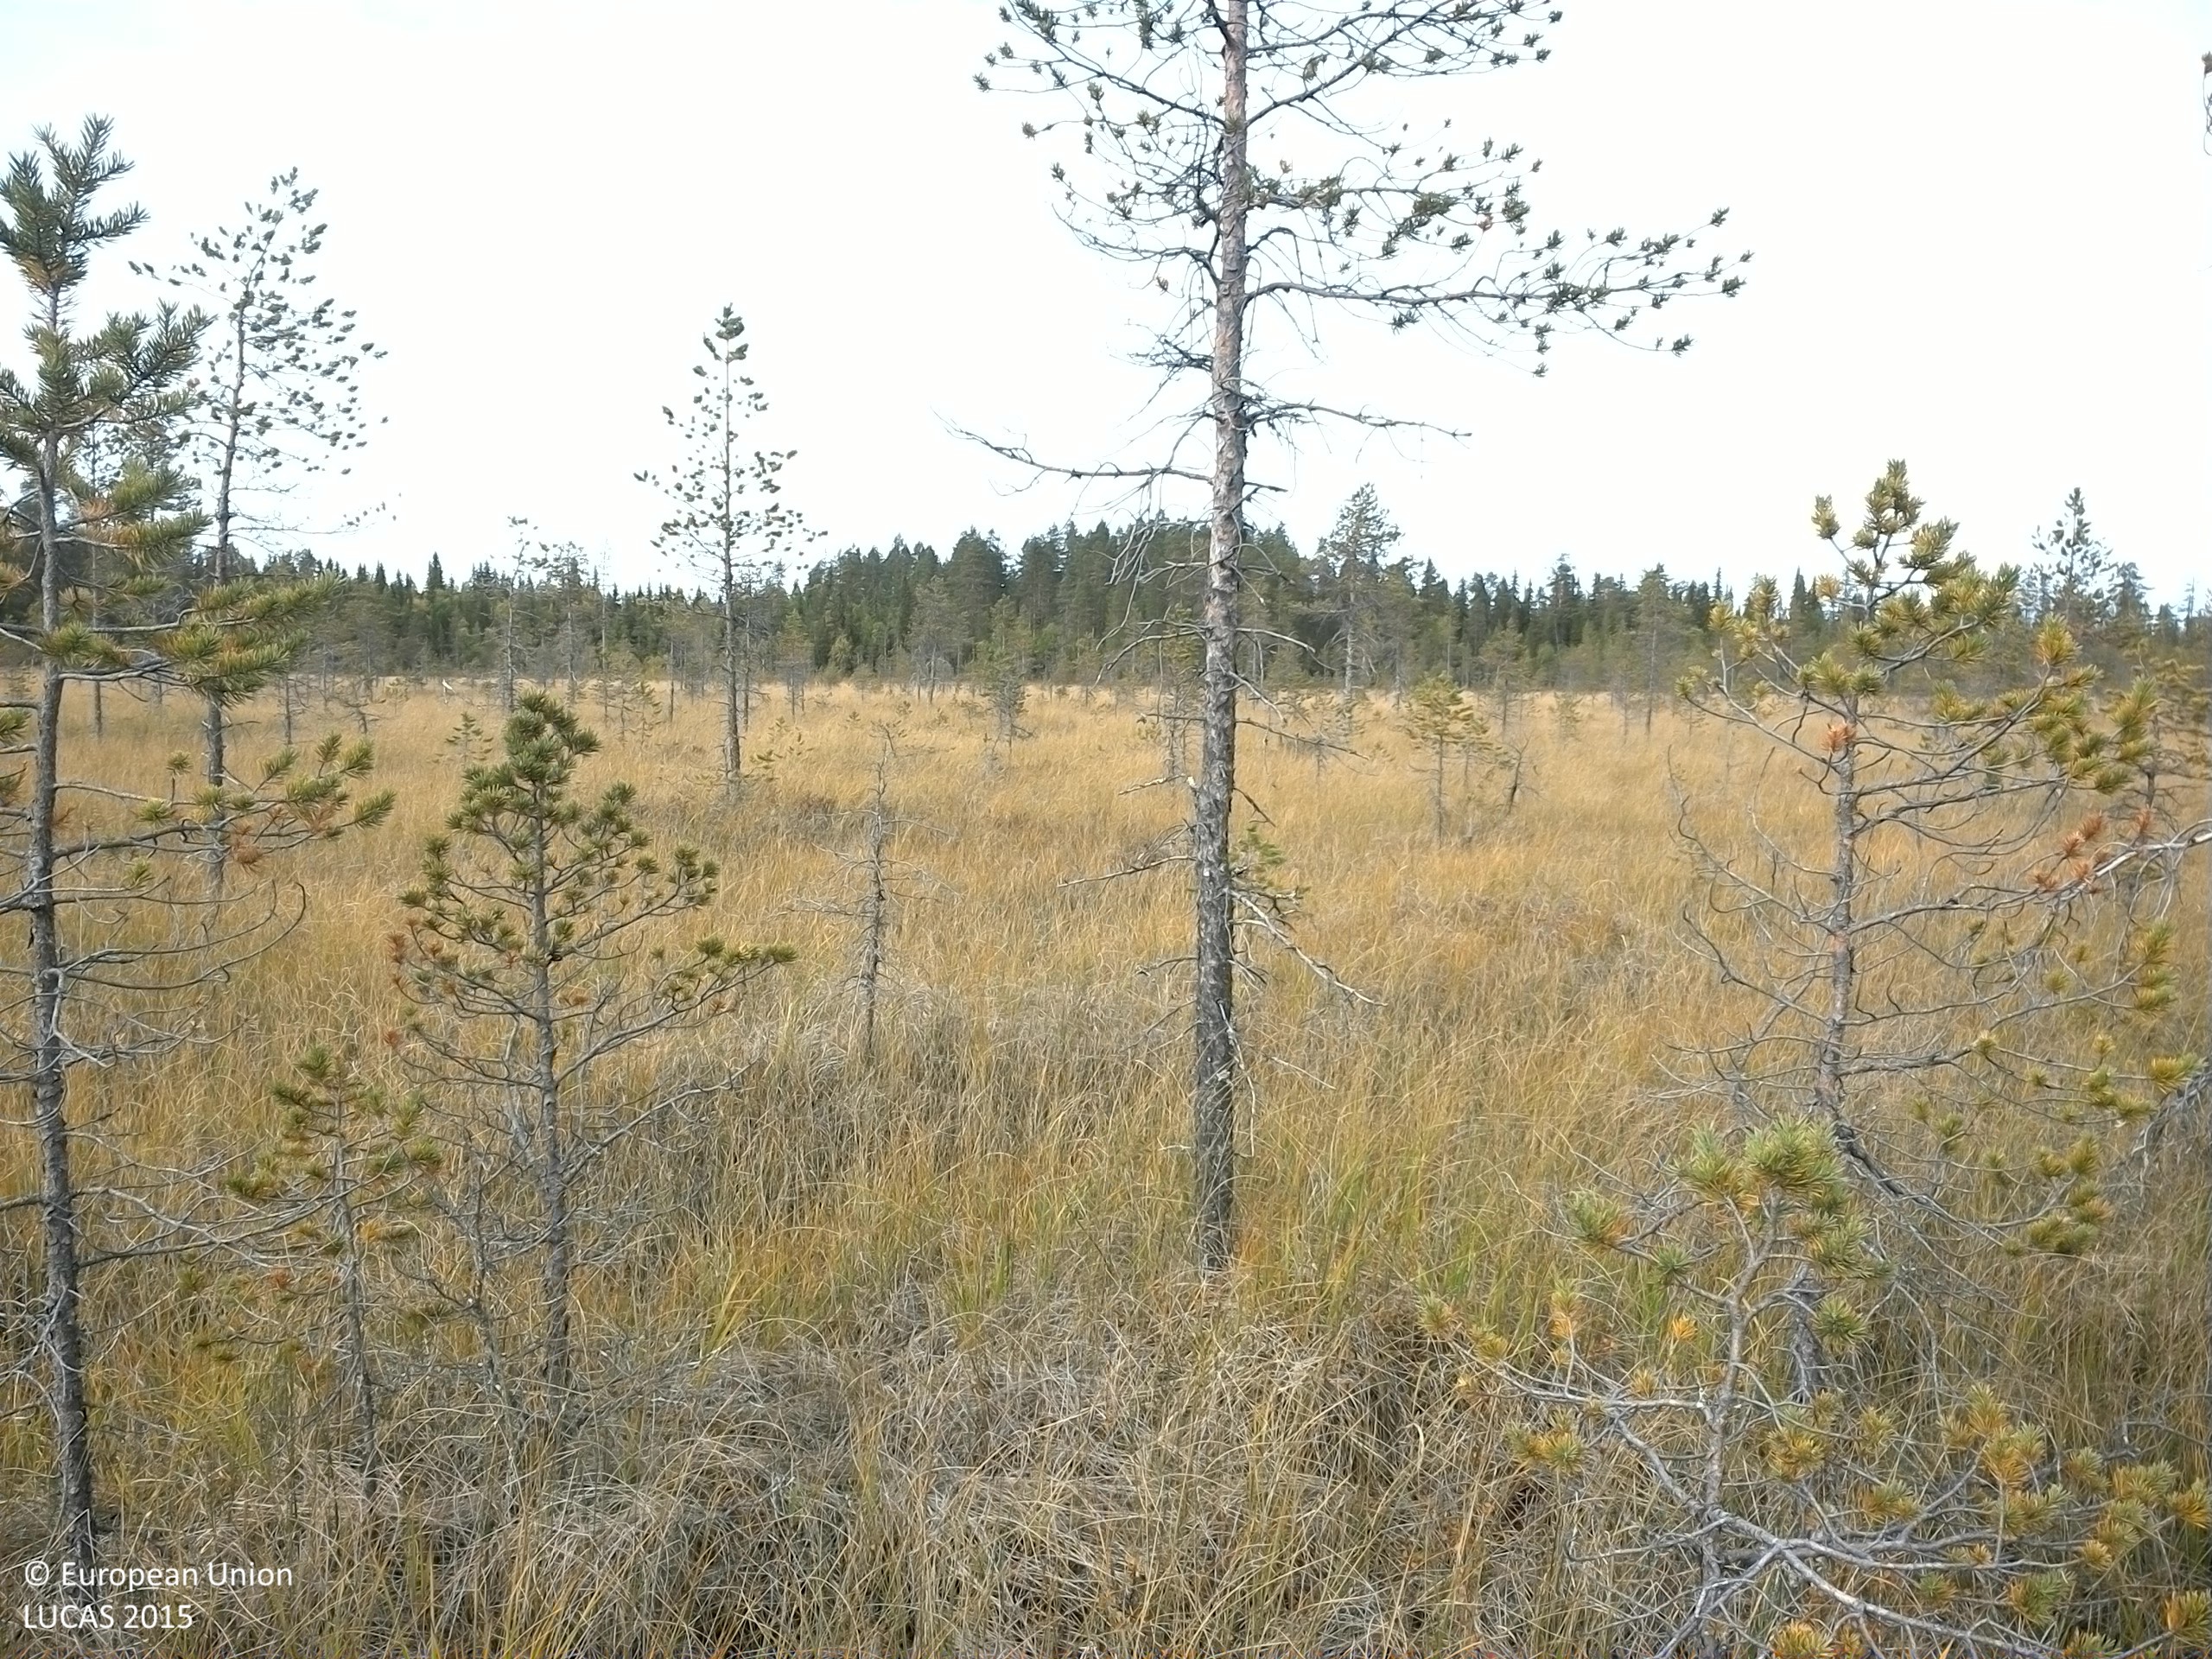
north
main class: Woodland
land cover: Pine dominated coniferous woodland
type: mire and swamp forests
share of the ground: 10 - 25 %
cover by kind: herbaceous plants 70 %, lichens and mosses 20 %, coniferous forest trees 10 %
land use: Semi-natural and natural areas not in use
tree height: < 5 m
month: September
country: SE
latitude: 64.0440
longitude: 16.5849
